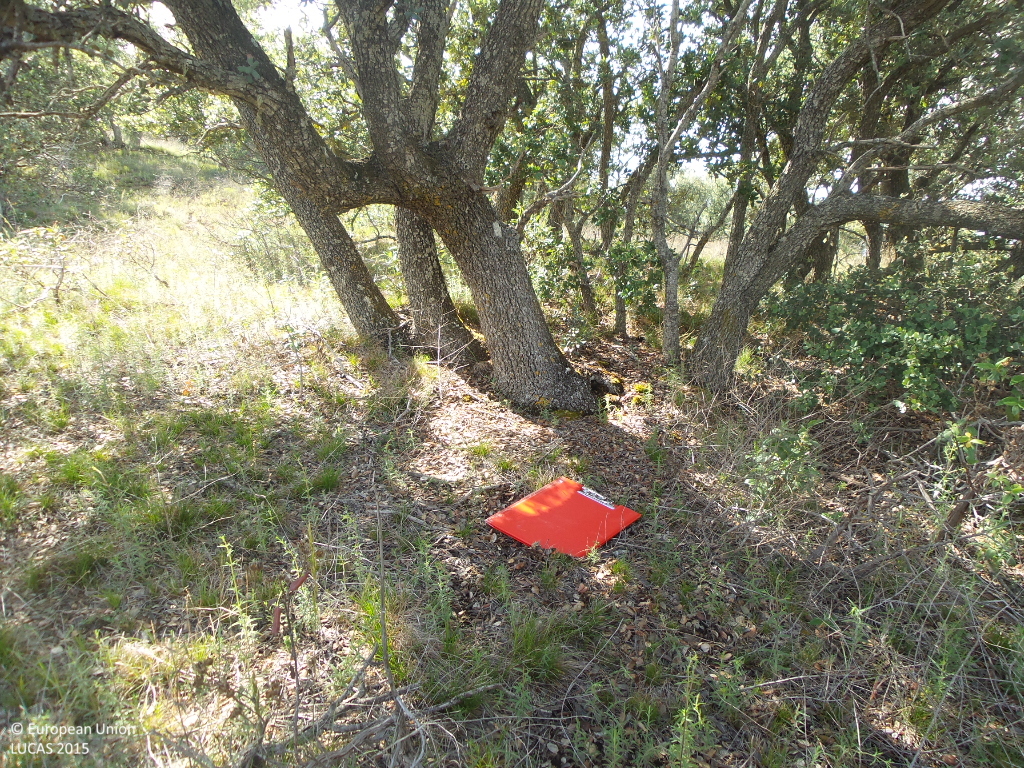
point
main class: Woodland
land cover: Broadleaved woodland
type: broadleaved evergreen forest
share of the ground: 25 - 50 %
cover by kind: broadleaved forest trees 35 %, shrubs 20 %, unconsolidated bare surface 20 %, herbaceous plants 15 %, consolidated bare surface 10 %
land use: Semi-natural and natural areas not in use
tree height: < 5 m
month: June
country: ES
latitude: 41.5164
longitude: -3.1646
